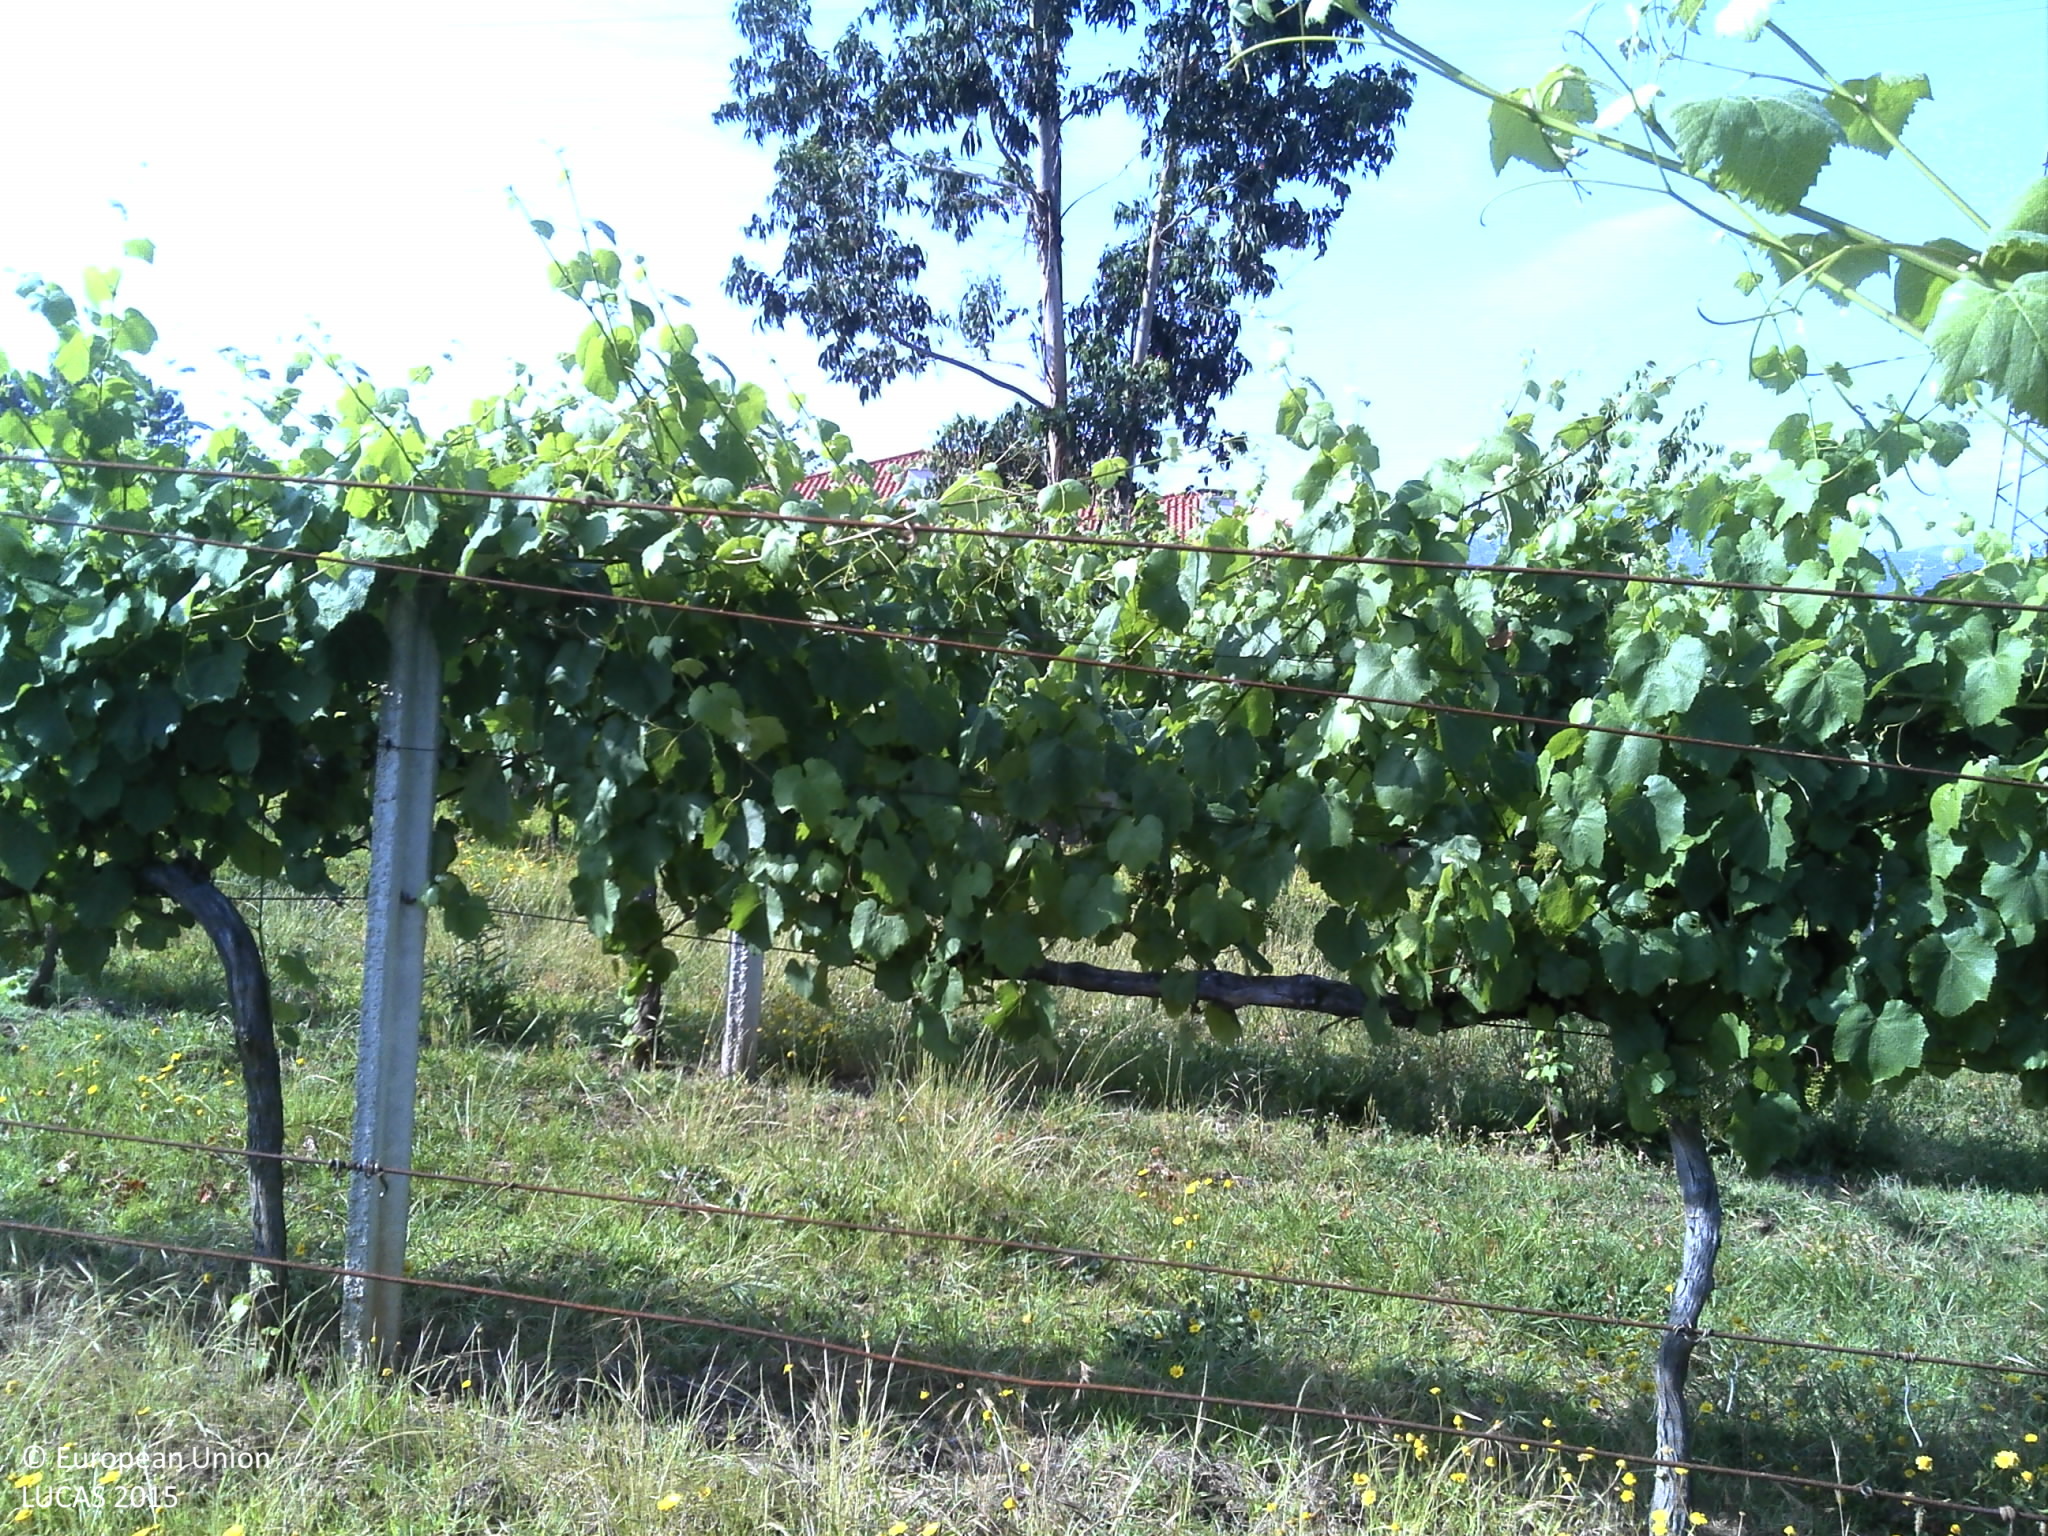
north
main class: Cropland
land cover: Vineyards
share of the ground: 10 - 25 %
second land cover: Grassland without tree/shrub cover
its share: 25 - 50 %
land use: Agriculture (excluding fallow land and kitchen gardens)
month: June
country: PT
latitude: 42.0689
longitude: -8.4488
